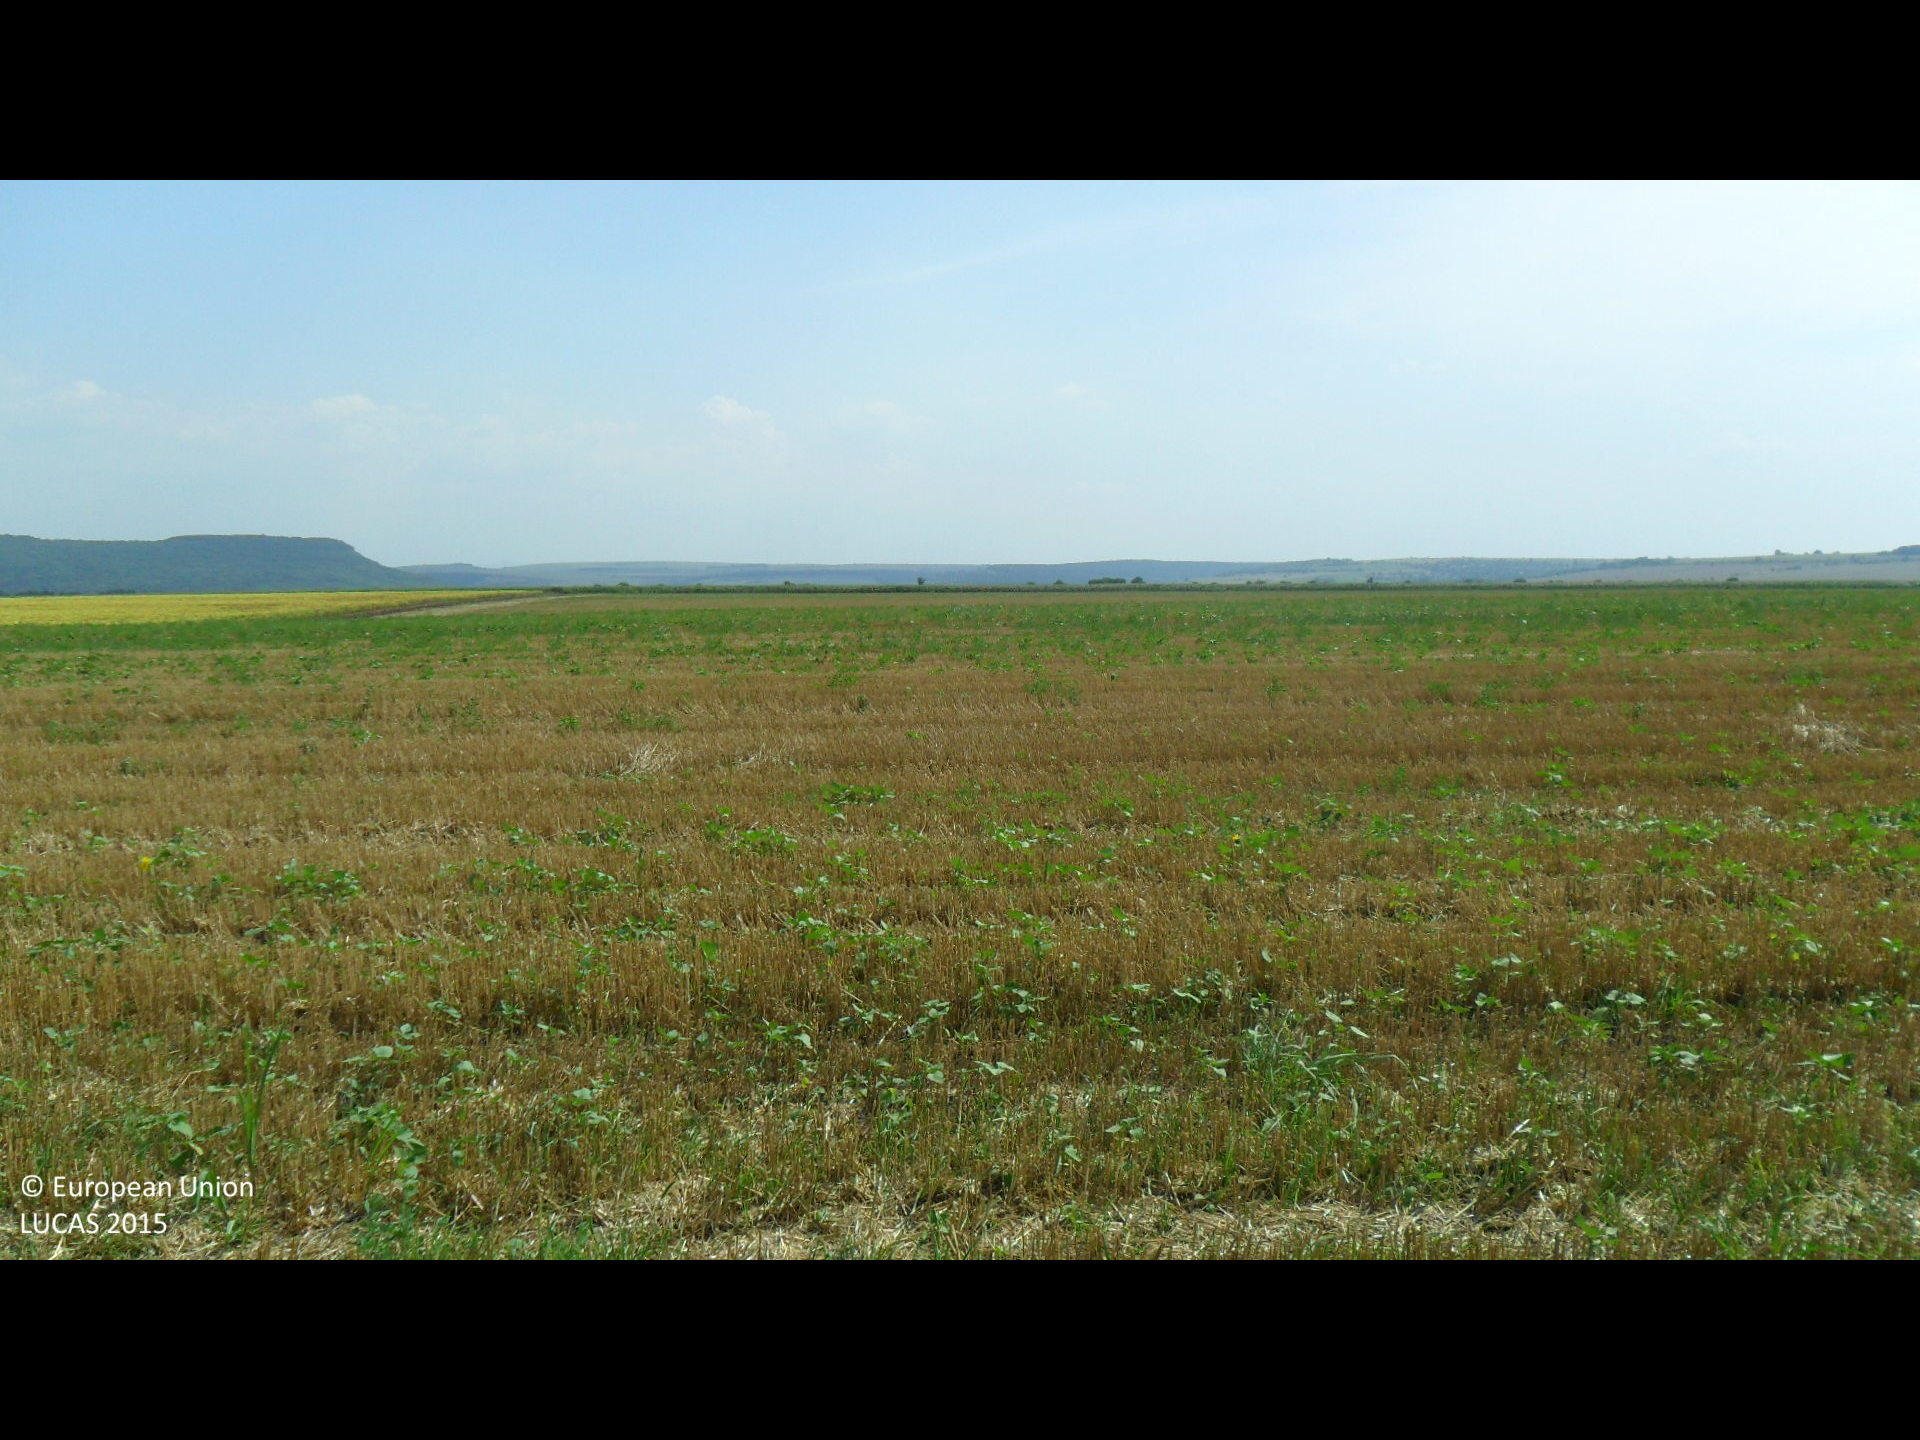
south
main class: Grassland
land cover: Spontaneously vegetated surfaces
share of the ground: > 75 %
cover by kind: herbaceous plants 100 %
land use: Semi-natural and natural areas not in use
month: August
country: BG
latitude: 43.3147
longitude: 26.2611
